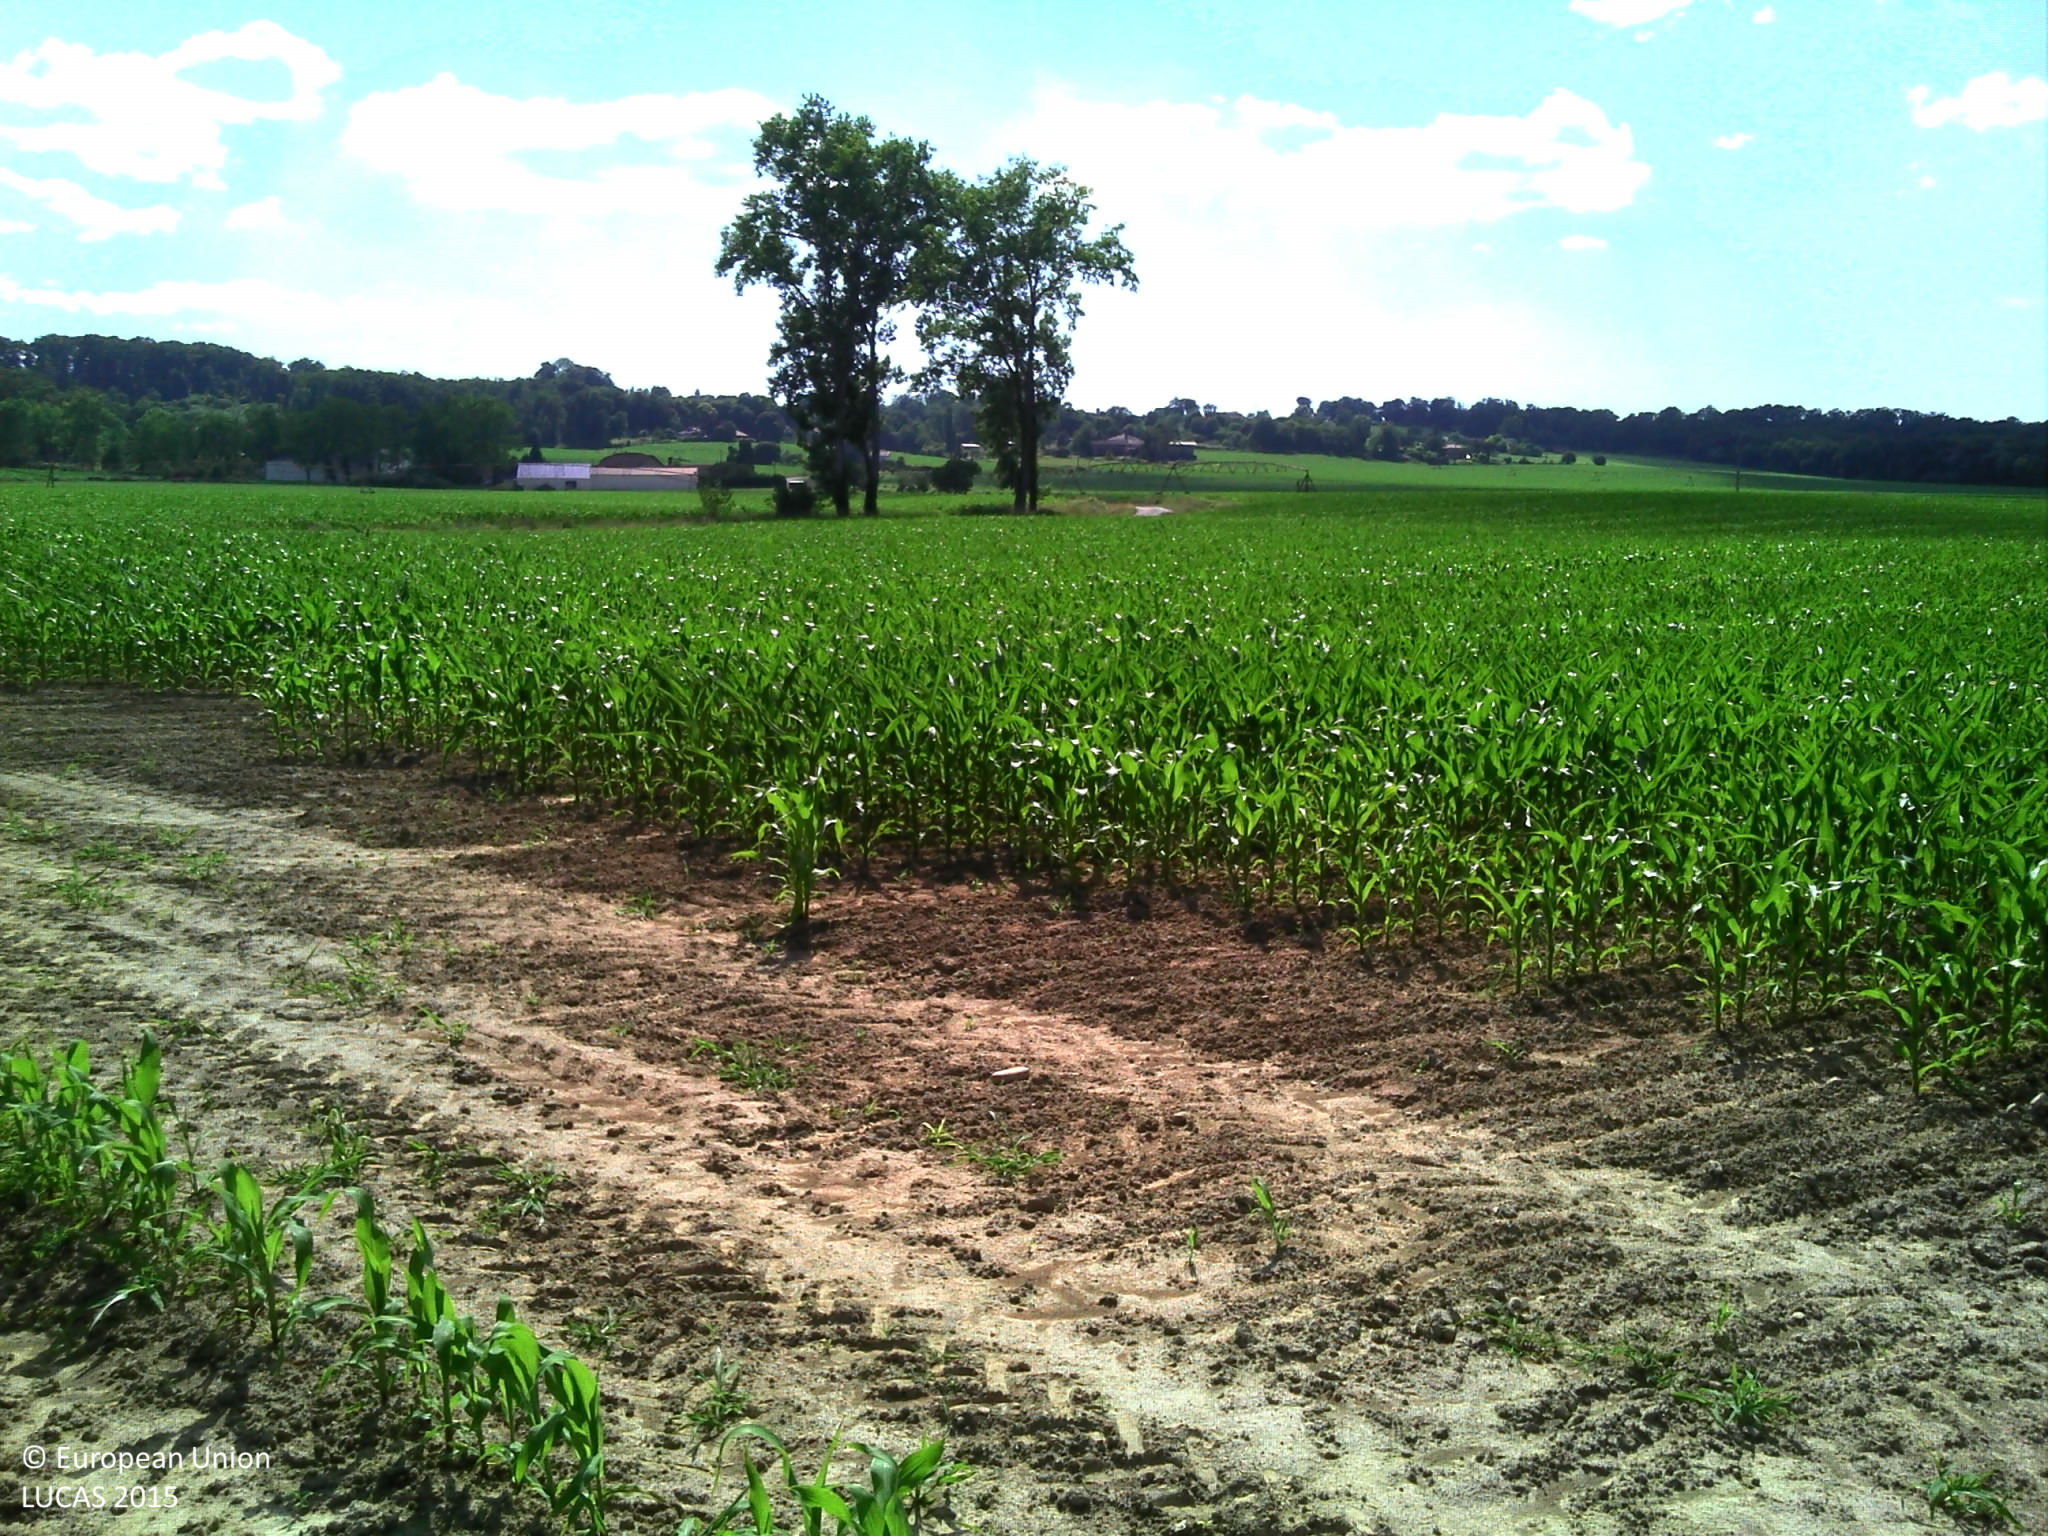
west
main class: Cropland
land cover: Sunflower
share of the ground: 50 - 75 %
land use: Agriculture (excluding fallow land and kitchen gardens)
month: June
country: FR
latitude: 43.6745
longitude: -0.4661
